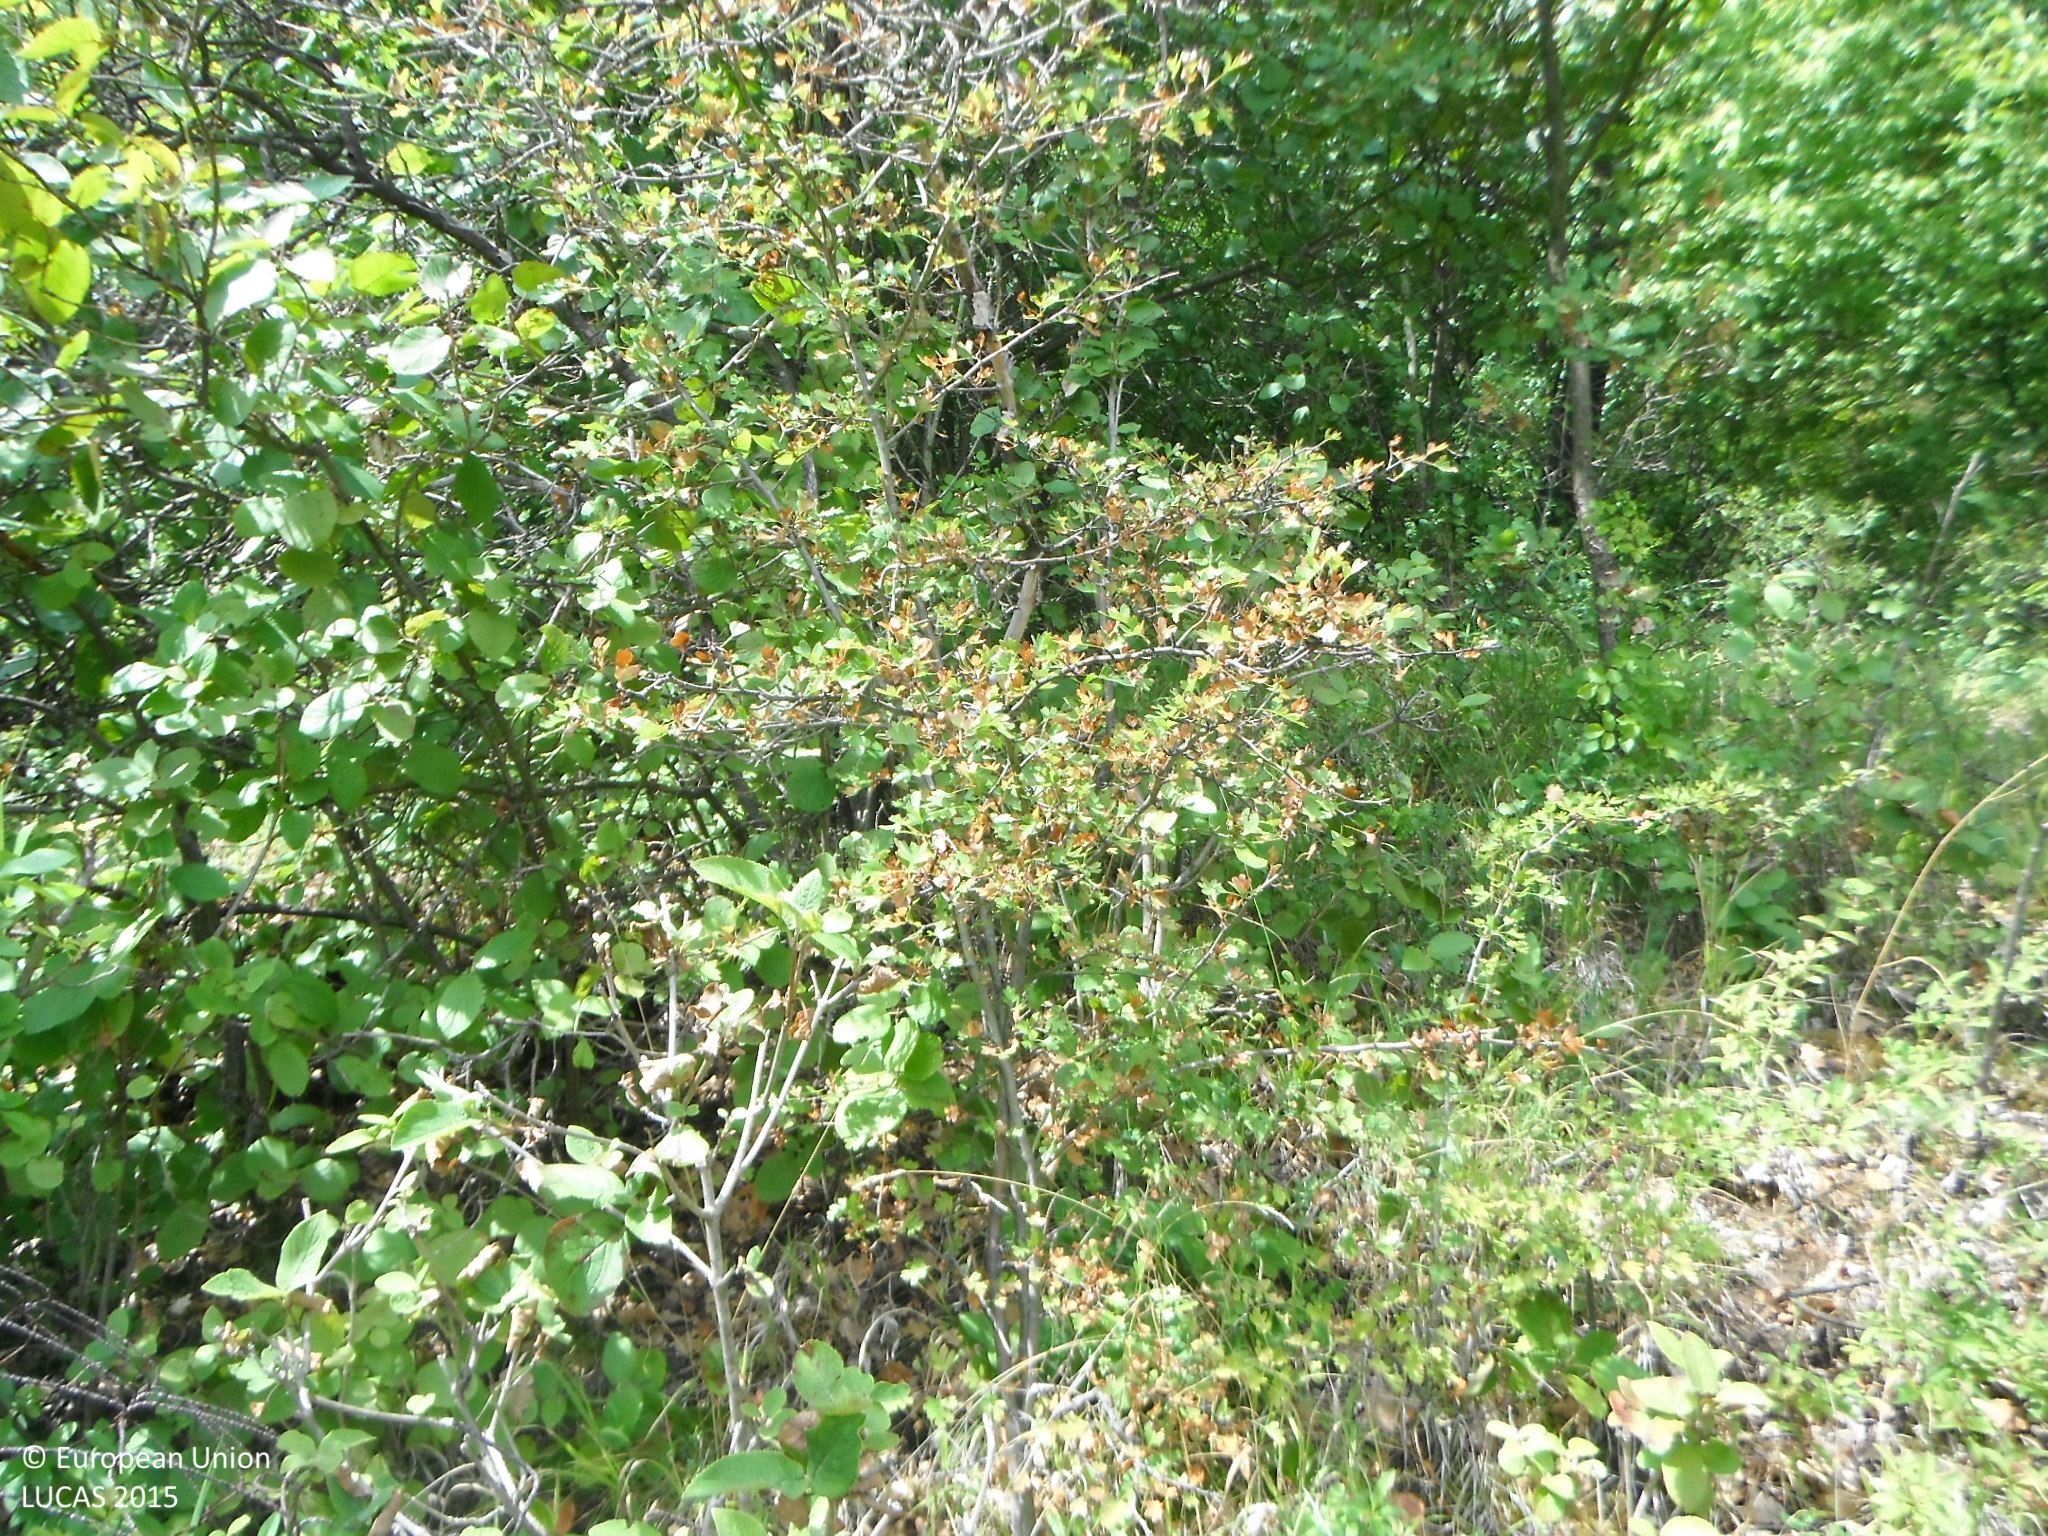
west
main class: Woodland
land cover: Broadleaved woodland
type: acidophilous oak and oak-birch forest
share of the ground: 50 - 75 %
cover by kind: broadleaved forest trees 60 %, shrubs 30 %, coniferous forest trees 5 %, herbaceous plants 5 %
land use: Forestry
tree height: > 5 m
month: July
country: SK
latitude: 48.7301
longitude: 18.4598
